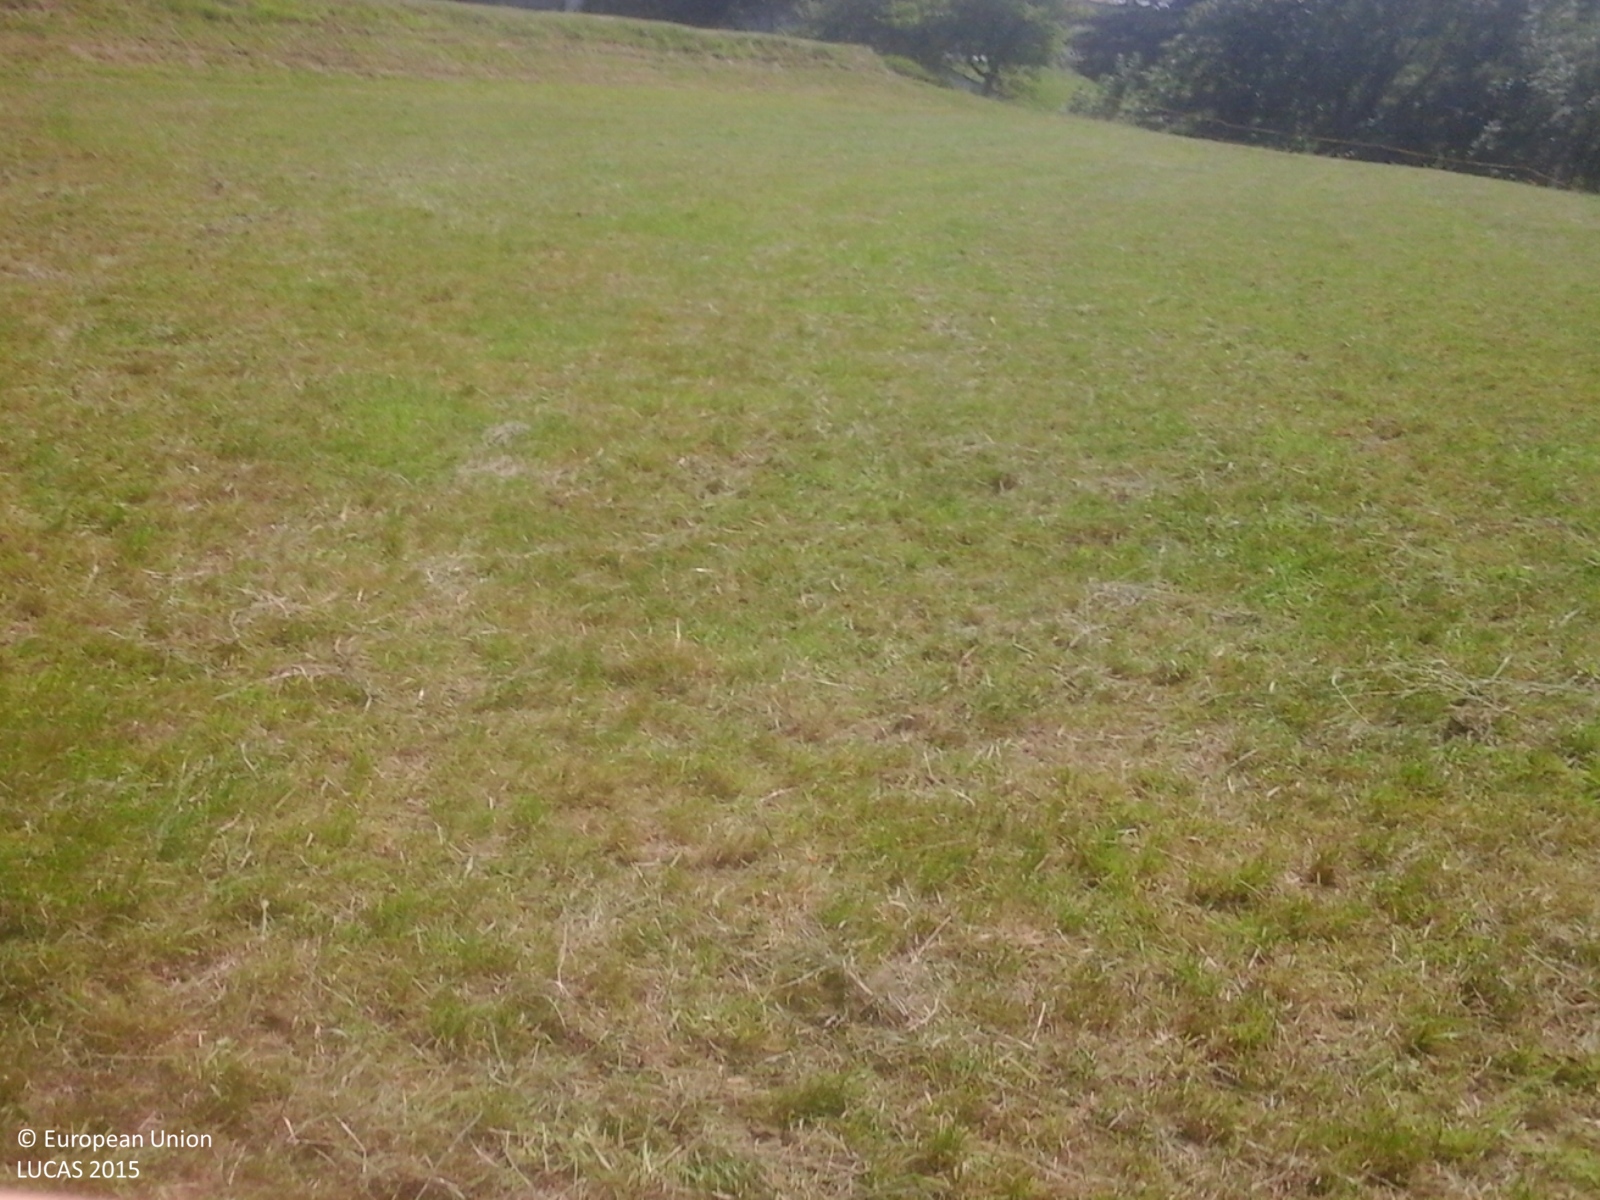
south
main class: Woodland
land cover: Broadleaved woodland
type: thermophilous deciduous forest
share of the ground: > 75 %
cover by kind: broadleaved forest trees 95 %, shrubs 5 %
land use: Forestry
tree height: > 5 m
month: July
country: IT
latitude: 45.8089
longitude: 9.3704
